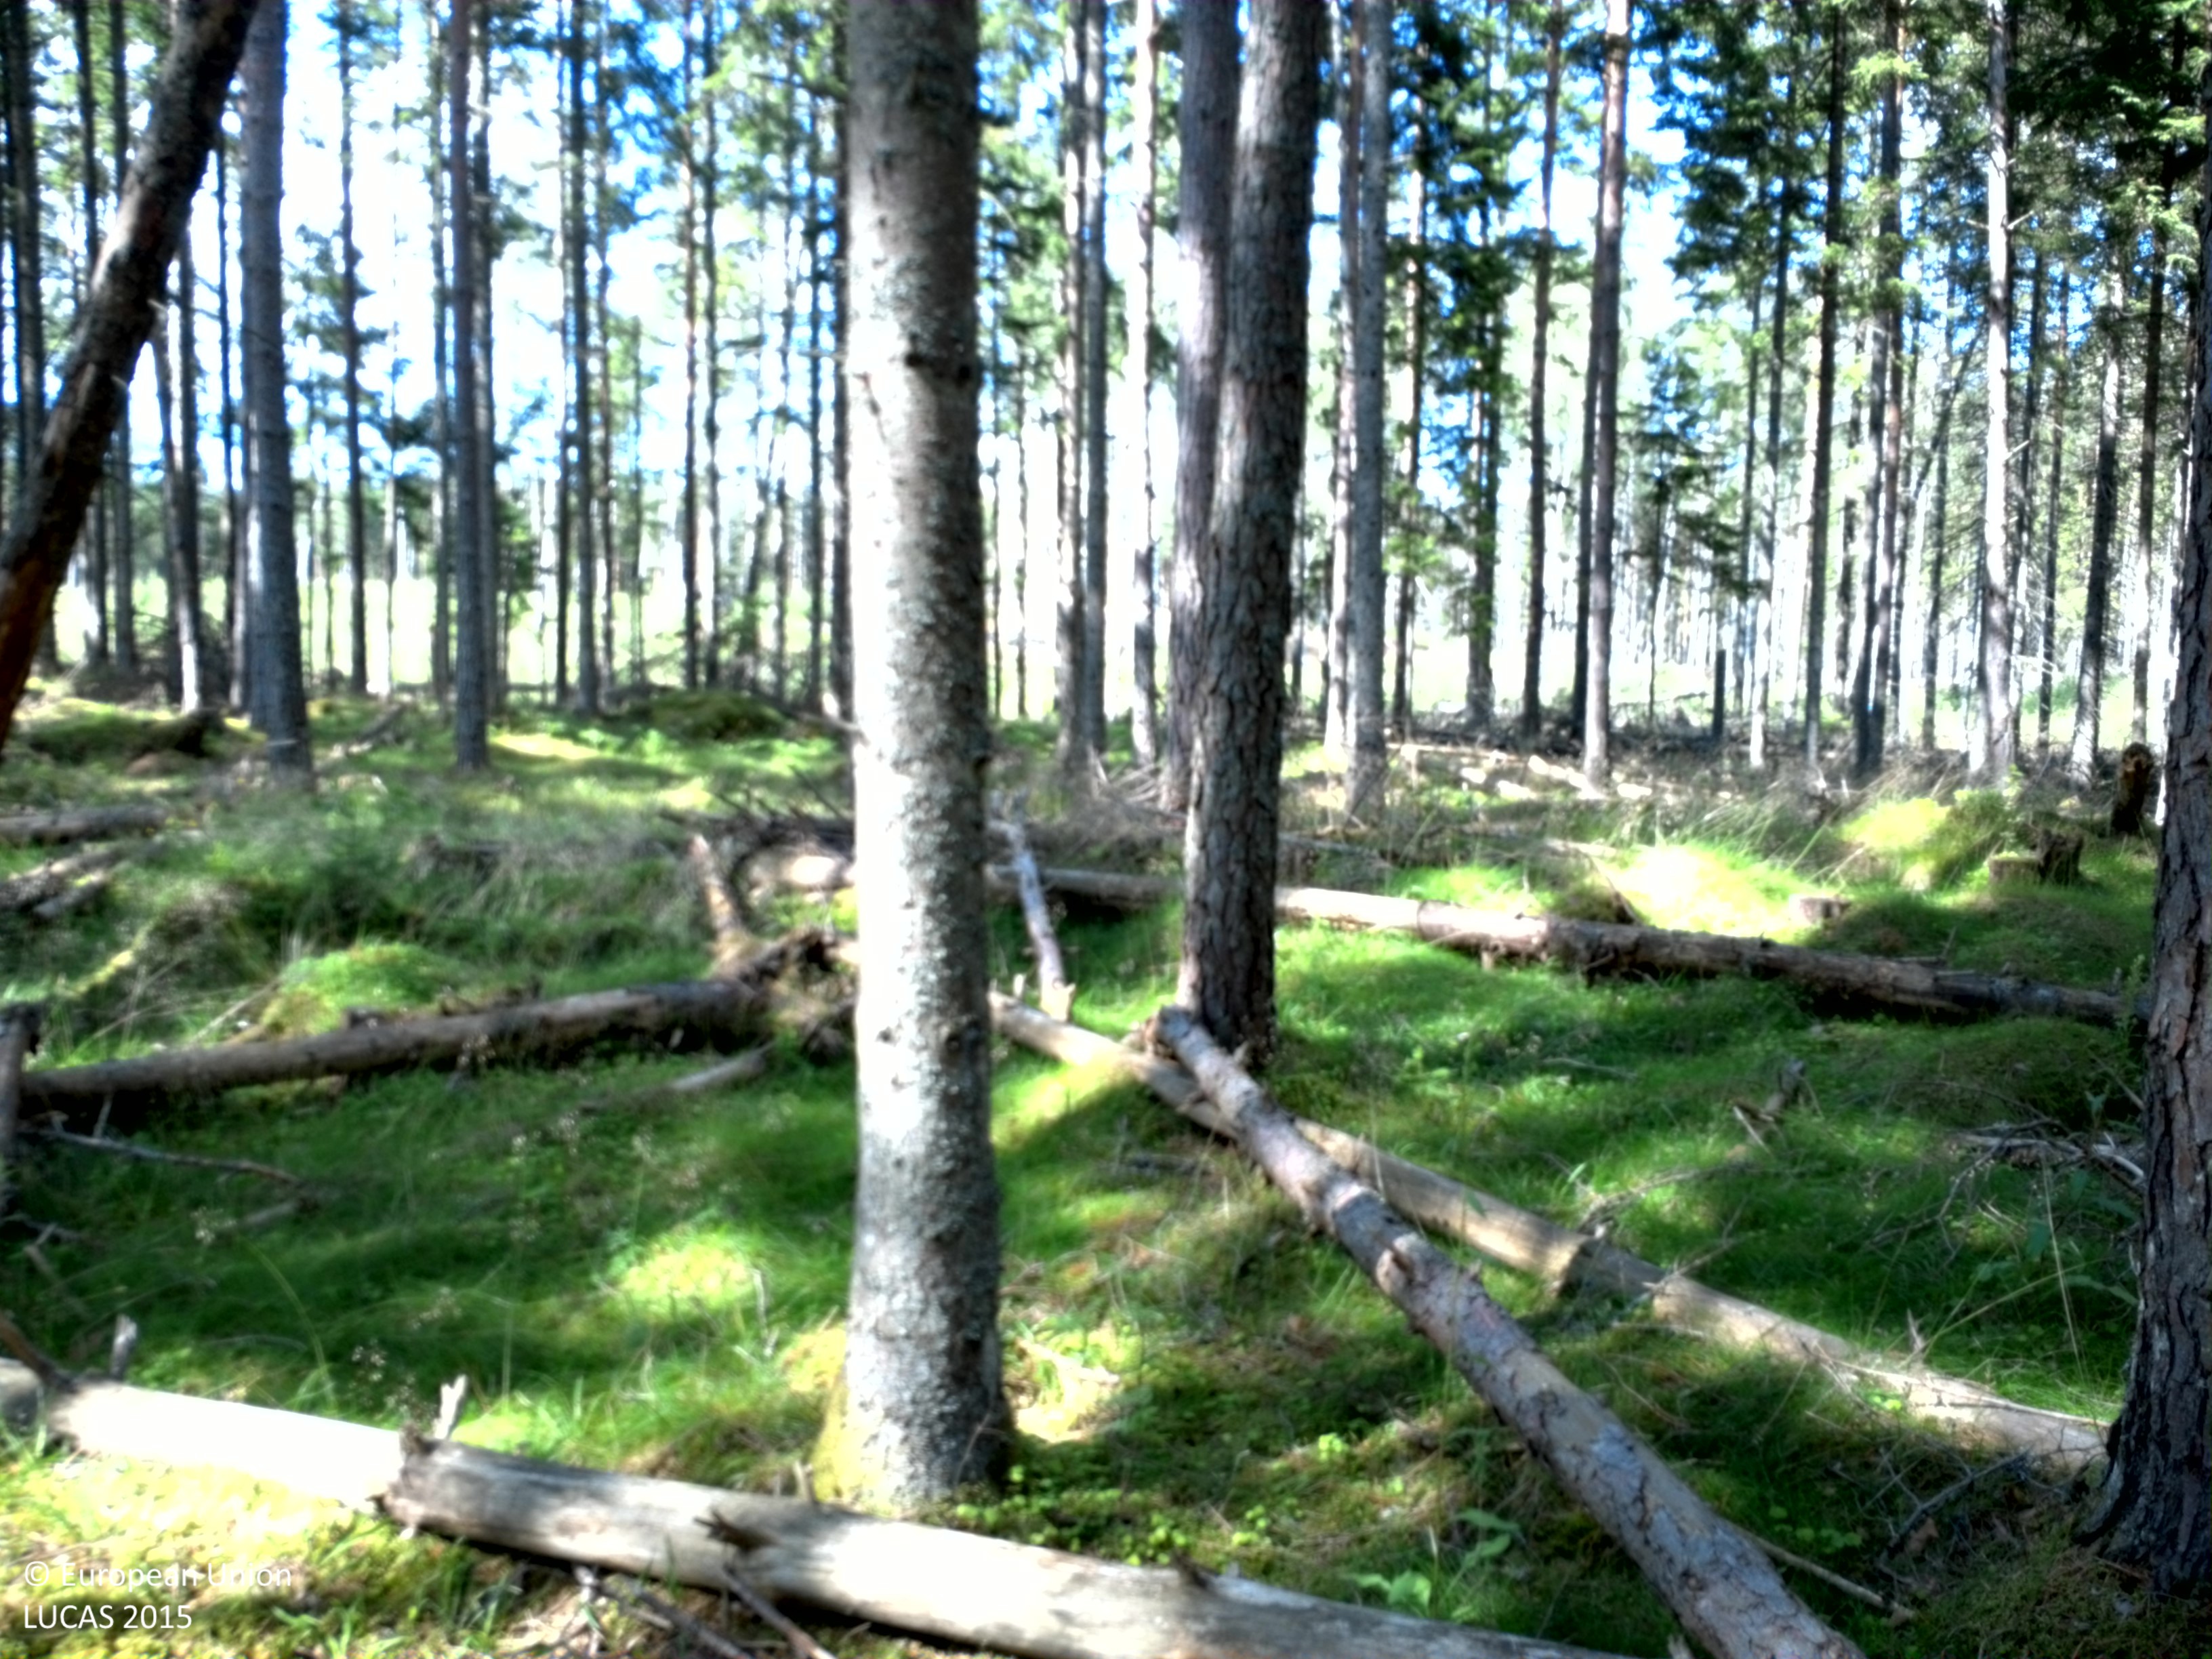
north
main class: Woodland
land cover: Spruce dominated coniferous woodland
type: boreal forest
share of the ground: 25 - 50 %
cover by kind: lichens and mosses 50 %, coniferous forest trees 40 %, herbaceous plants 10 %
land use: Forestry
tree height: > 5 m
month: July
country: SE
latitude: 58.8125
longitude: 15.4469
